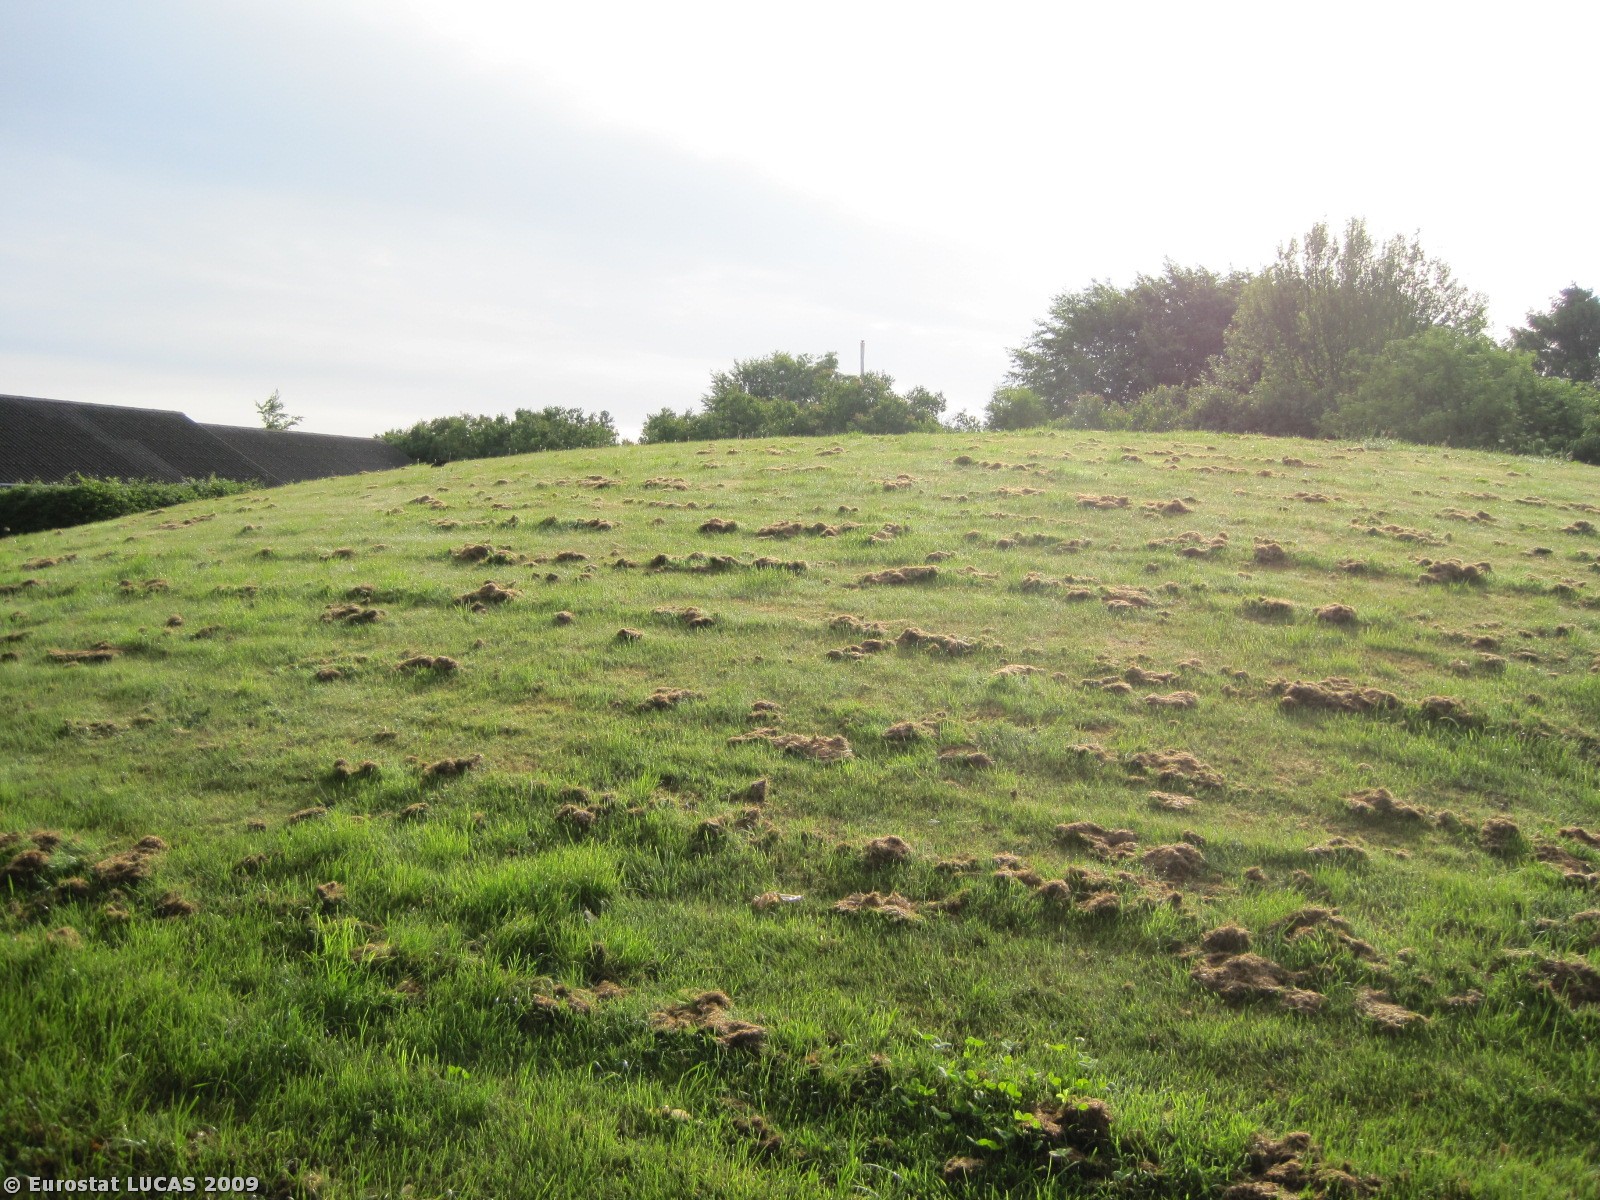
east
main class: Woodland
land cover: Broadleaved woodland
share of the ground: 50 - 75 %
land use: Amenities, museums, leisure
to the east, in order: Broadleaved woodland; Grass margins; Tracks; Grassland without tree/shrub cover; Broadleaved woodland; Artificial constructions in urban areas
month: June
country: DK
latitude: 57.1046
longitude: 10.0824
